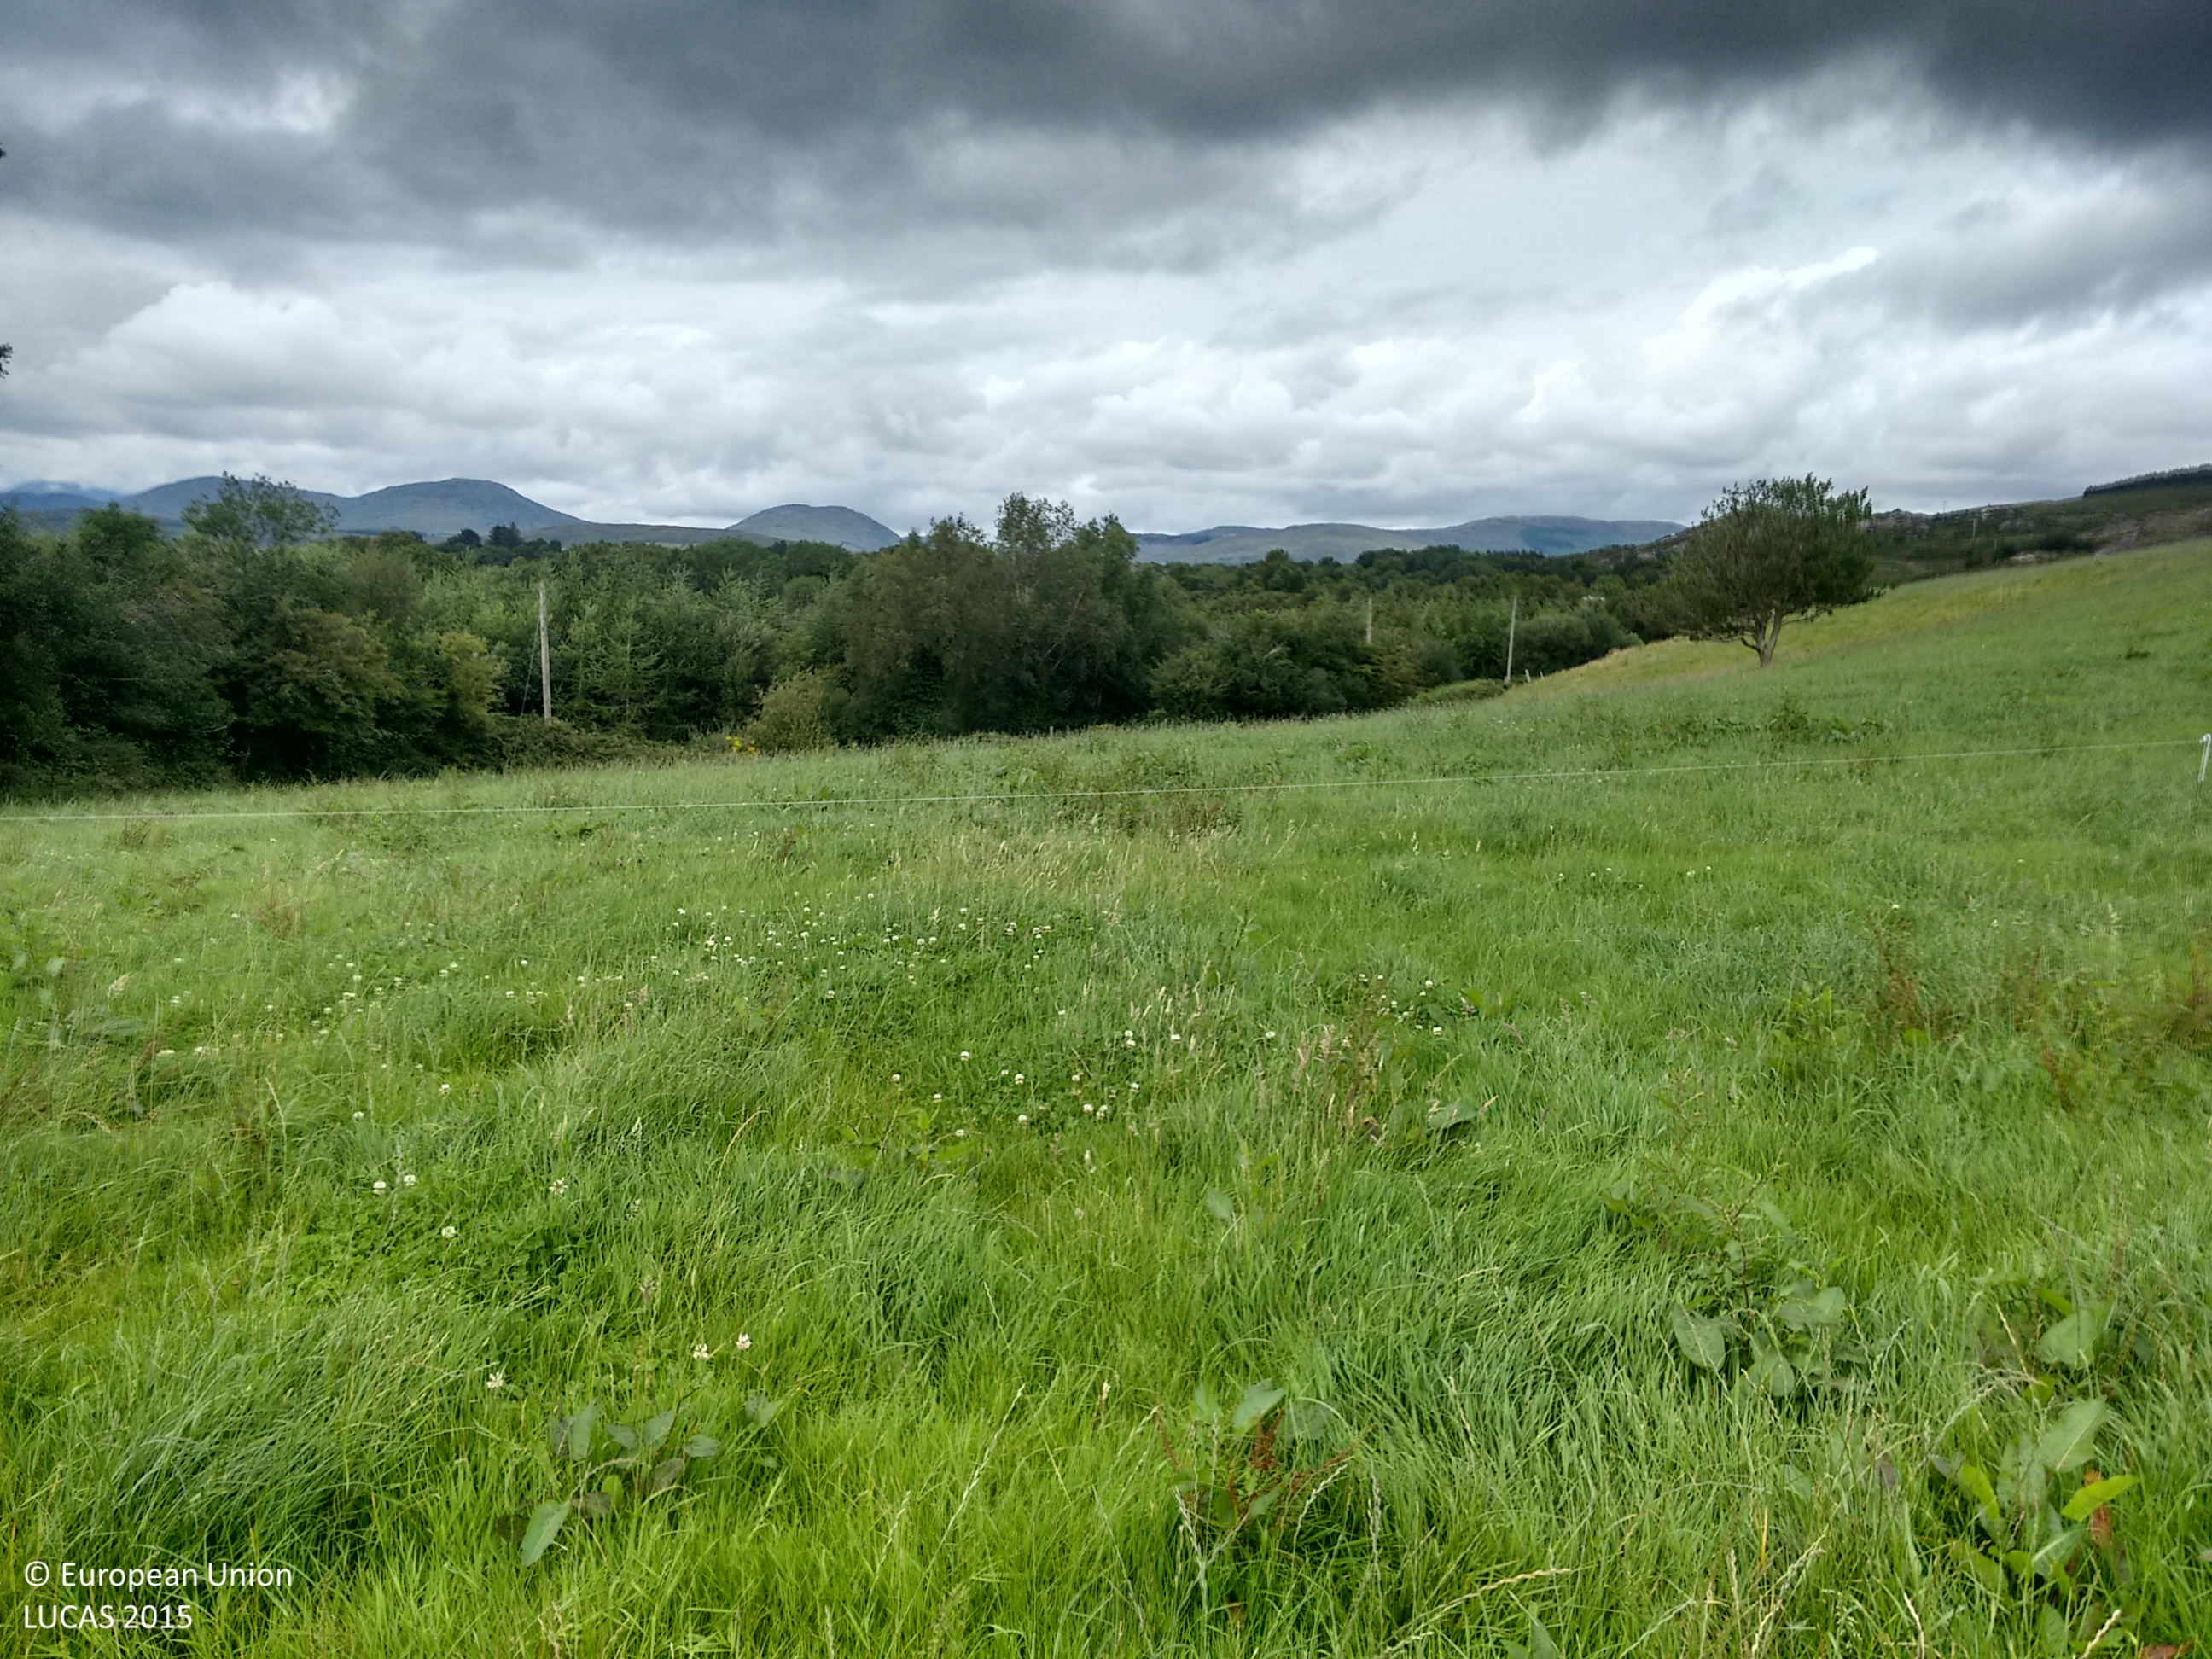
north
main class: Grassland
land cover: Grassland without tree/shrub cover
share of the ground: > 75 %
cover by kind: herbaceous plants 100 %
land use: Agriculture (excluding fallow land and kitchen gardens)
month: August
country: IE
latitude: 51.8612
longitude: -9.5325
